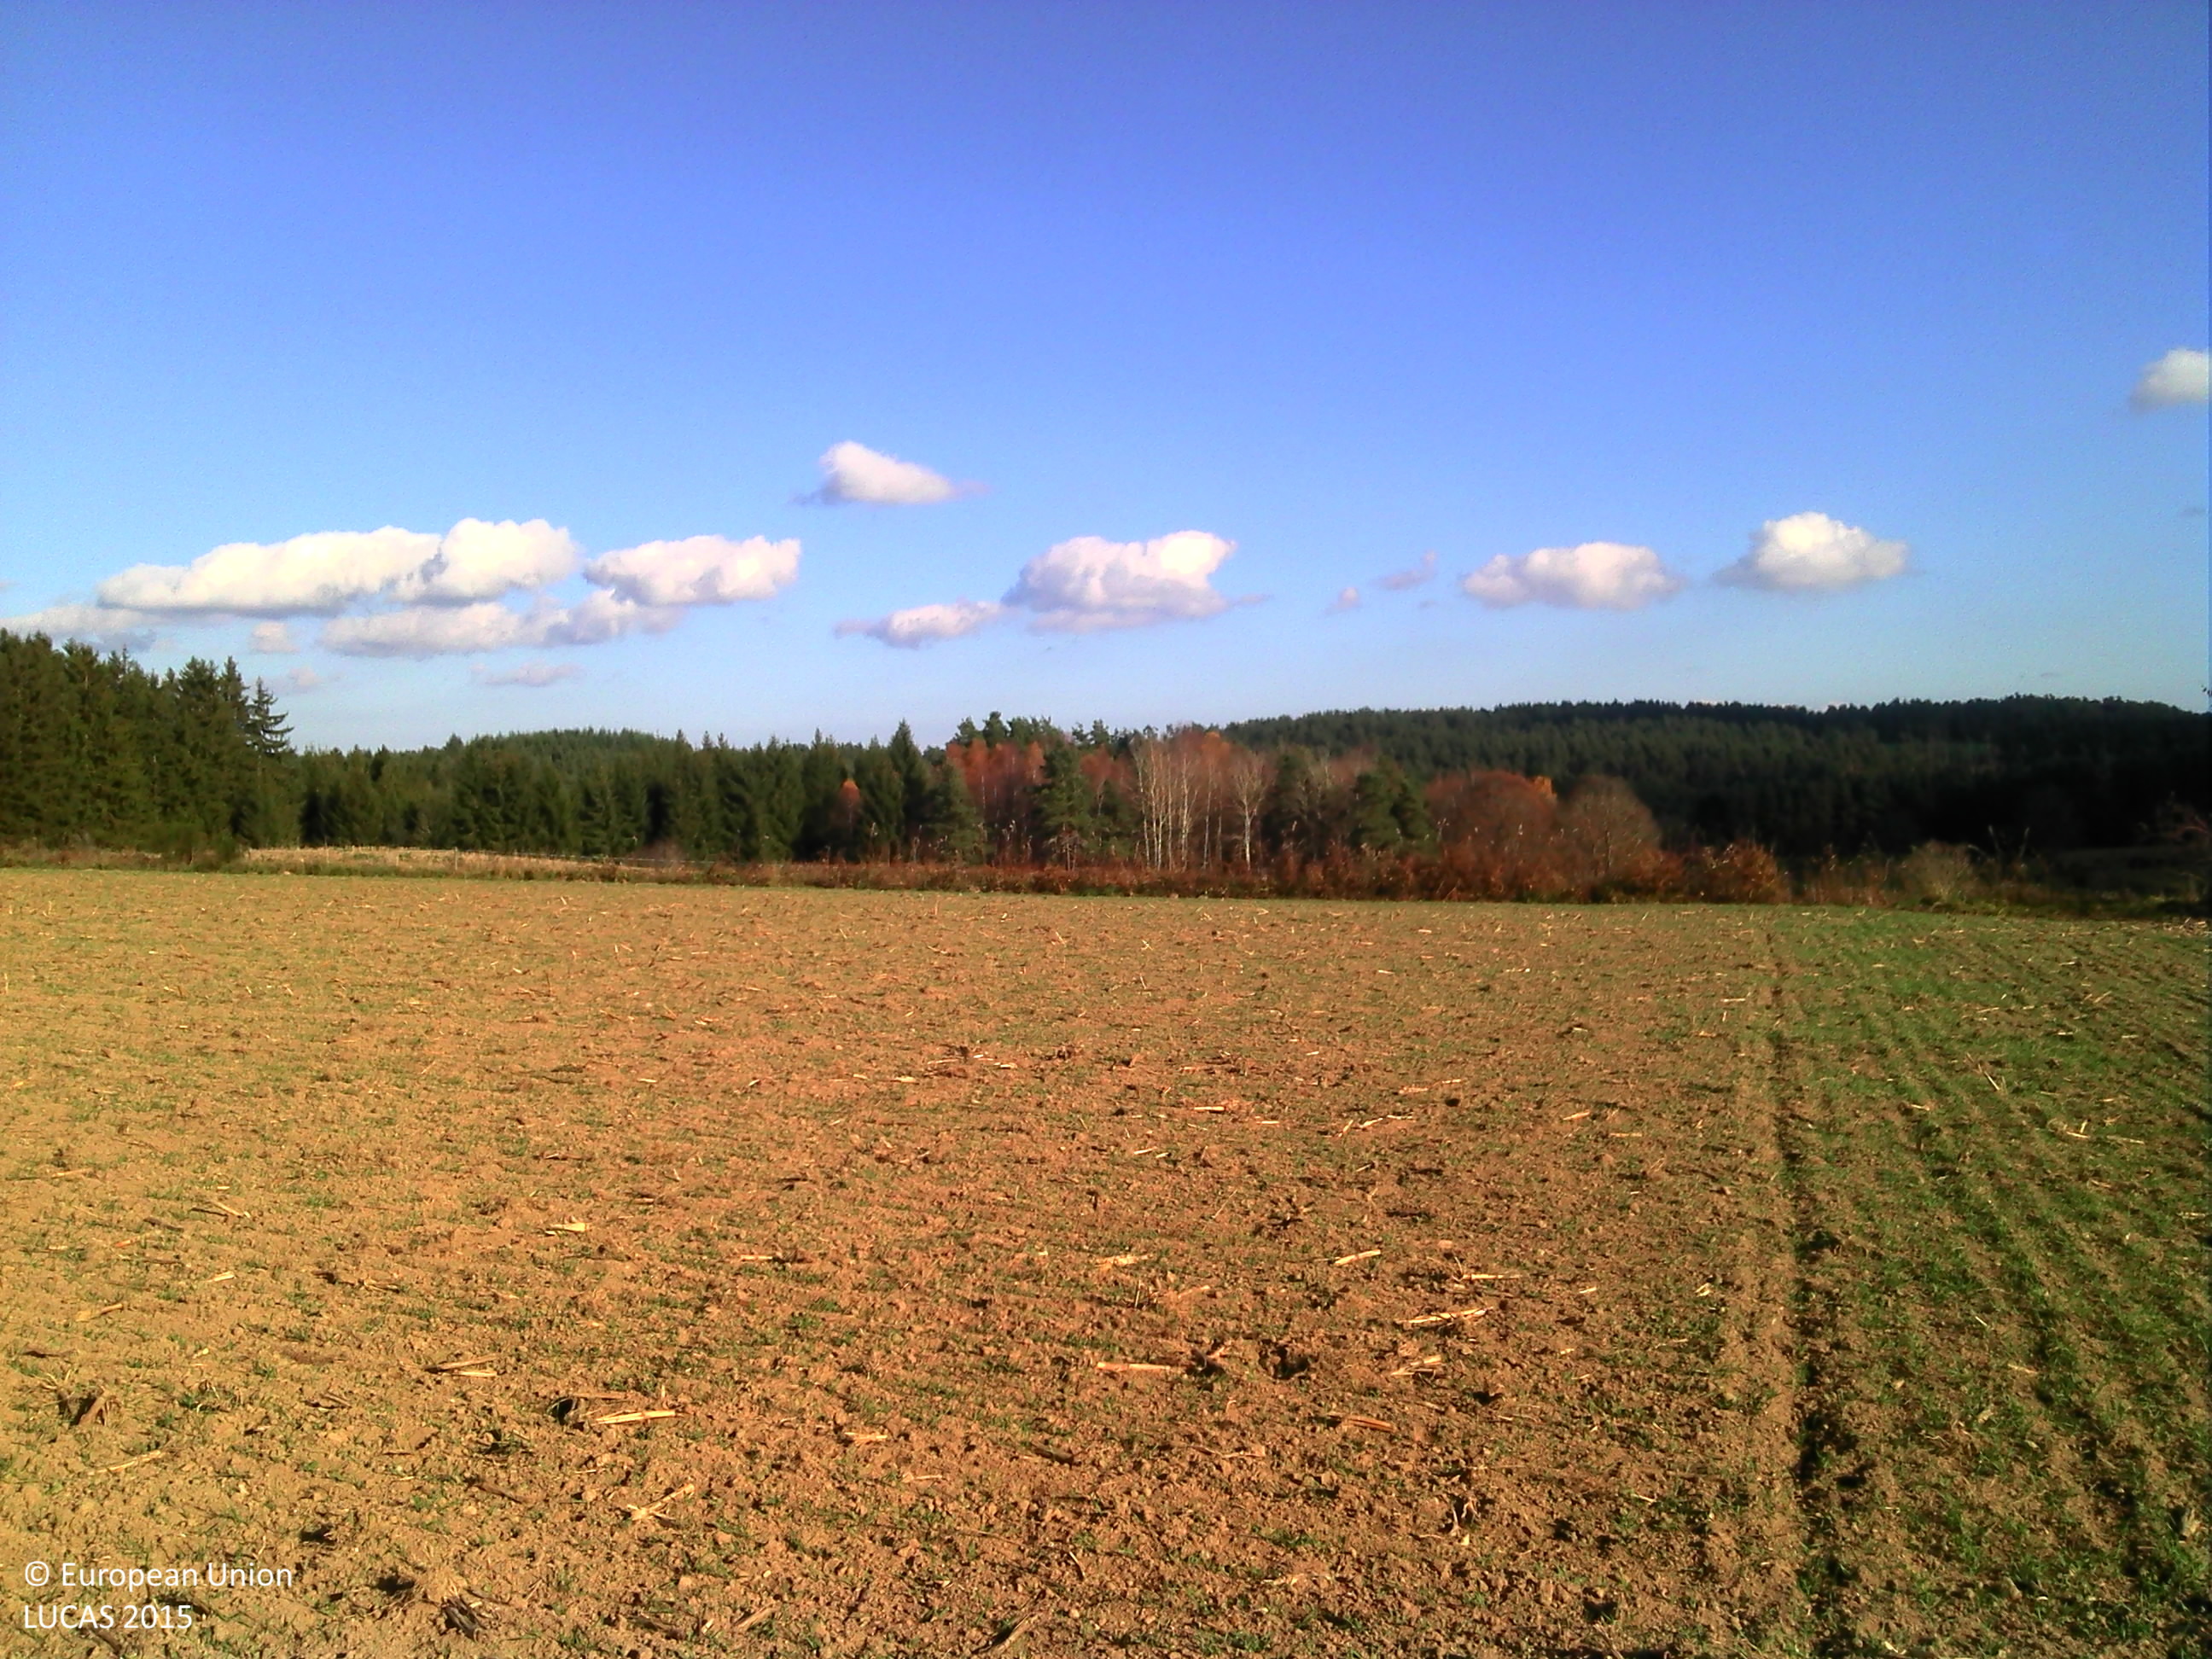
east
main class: Cropland
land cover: Temporary grasslands
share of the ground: 10 - 25 %
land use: Agriculture (excluding fallow land and kitchen gardens)
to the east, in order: Temporary grasslands; Spontaneously vegetated surfaces; Ditches and canals; Grass margins; Paved roads, cycling and walking lanes; Grass margins; Dry stone walls; Grass margins; Maize; Grass margins; Fences; Grassland without tree/shrub cover; Fences; Pine dominated mixed woodland
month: November
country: FR
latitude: 45.2498
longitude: 3.7983
